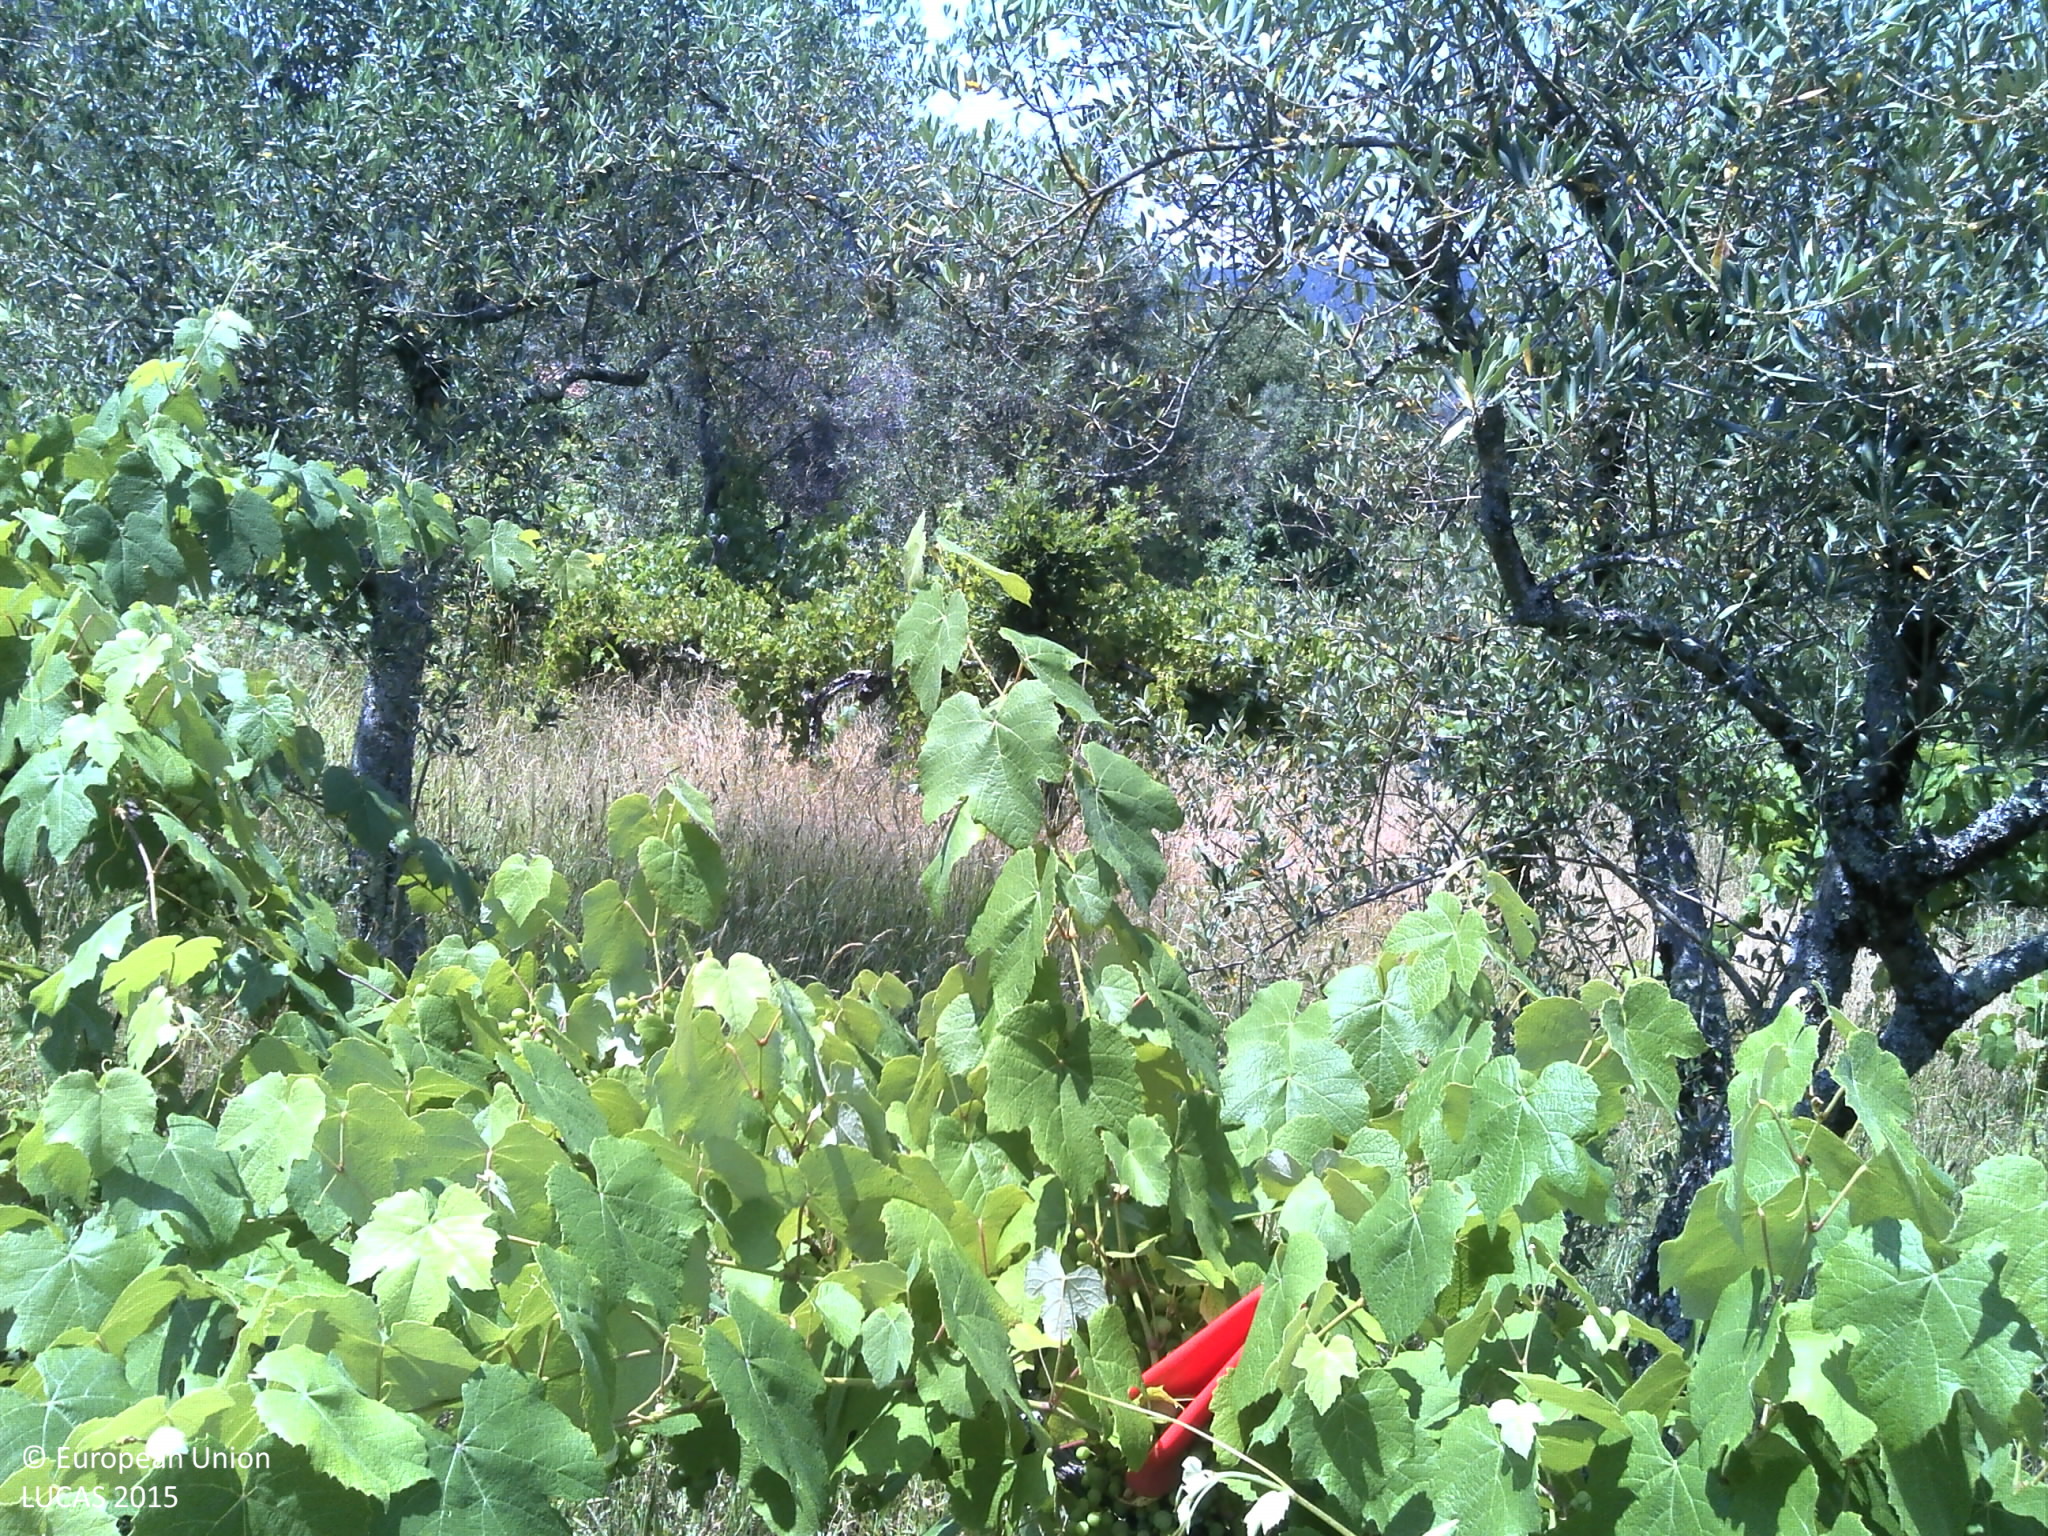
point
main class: Cropland
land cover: Vineyards
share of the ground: 25 - 50 %
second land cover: Grassland without tree/shrub cover
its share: 25 - 50 %
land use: Agriculture (excluding fallow land and kitchen gardens)
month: June
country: PT
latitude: 40.7144
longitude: -8.2825
